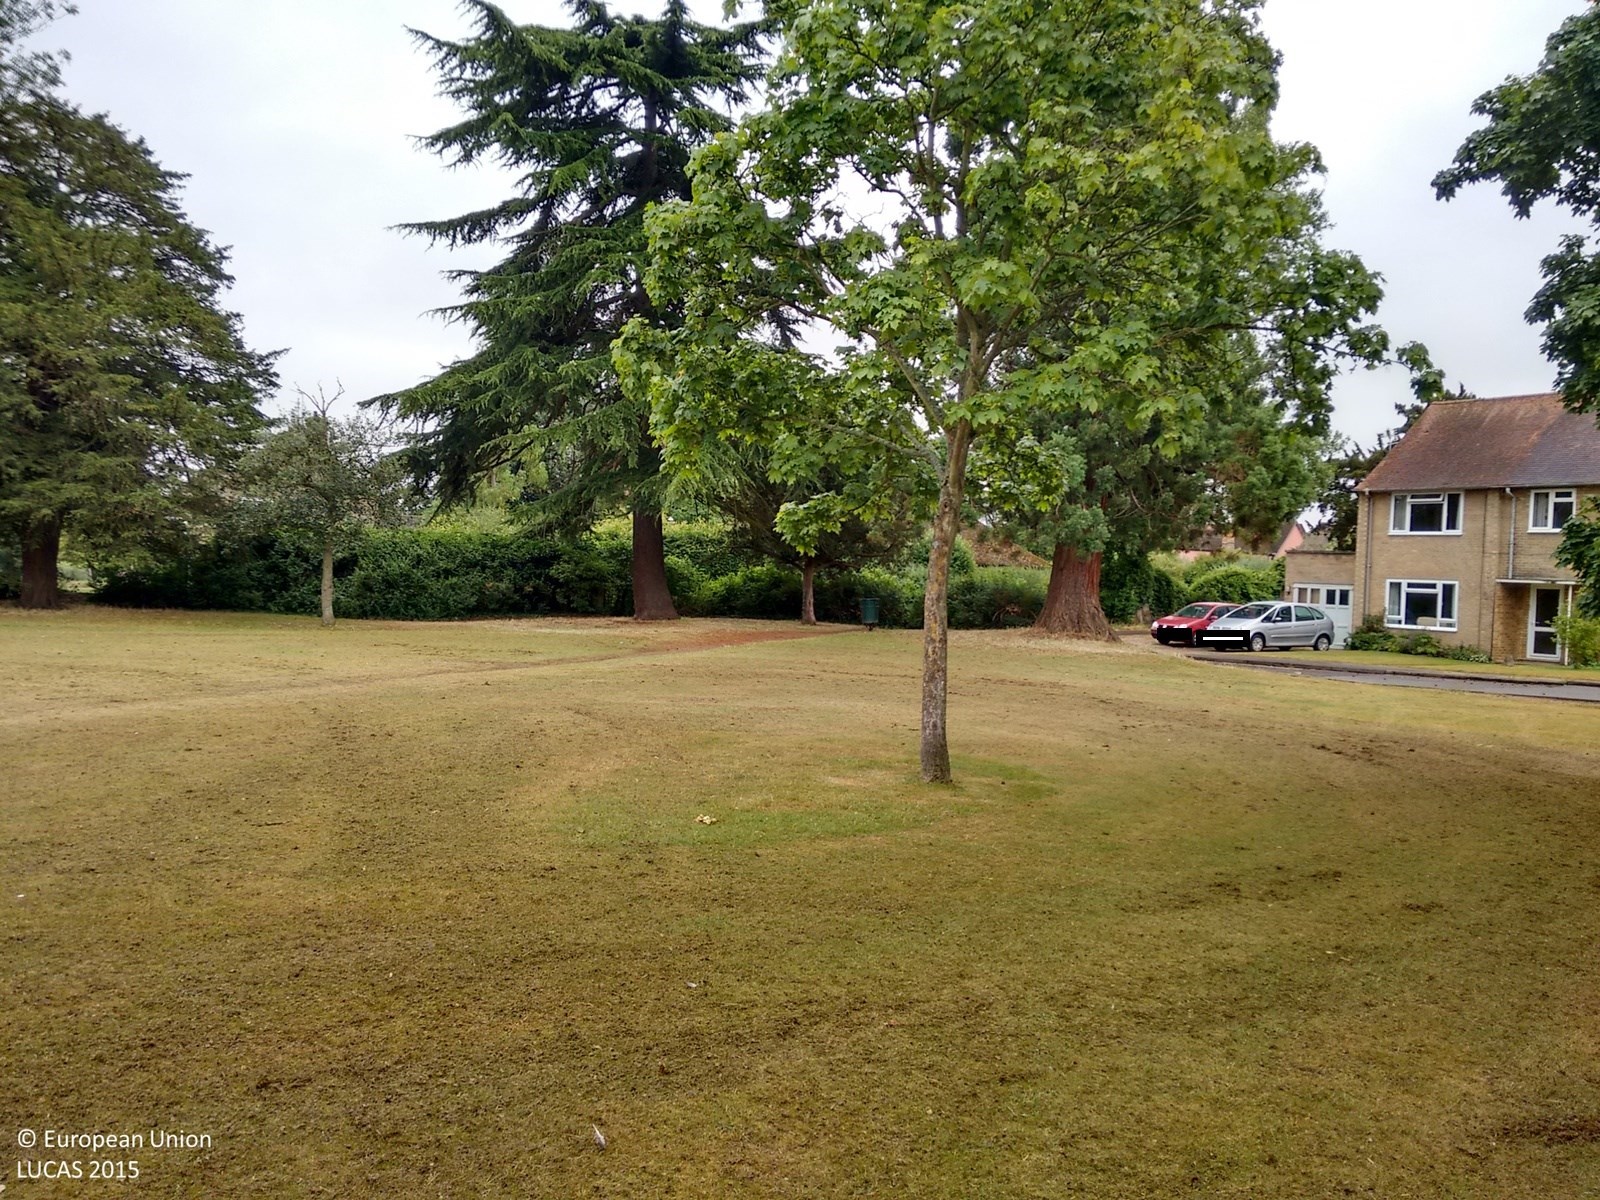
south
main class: Grassland
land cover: Grassland with sparse tree/shrub cover
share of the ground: > 75 %
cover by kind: herbaceous plants 95 %, broadleaved forest trees 5 %
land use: Residential
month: July
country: GB
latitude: 51.6740
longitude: -1.2842
